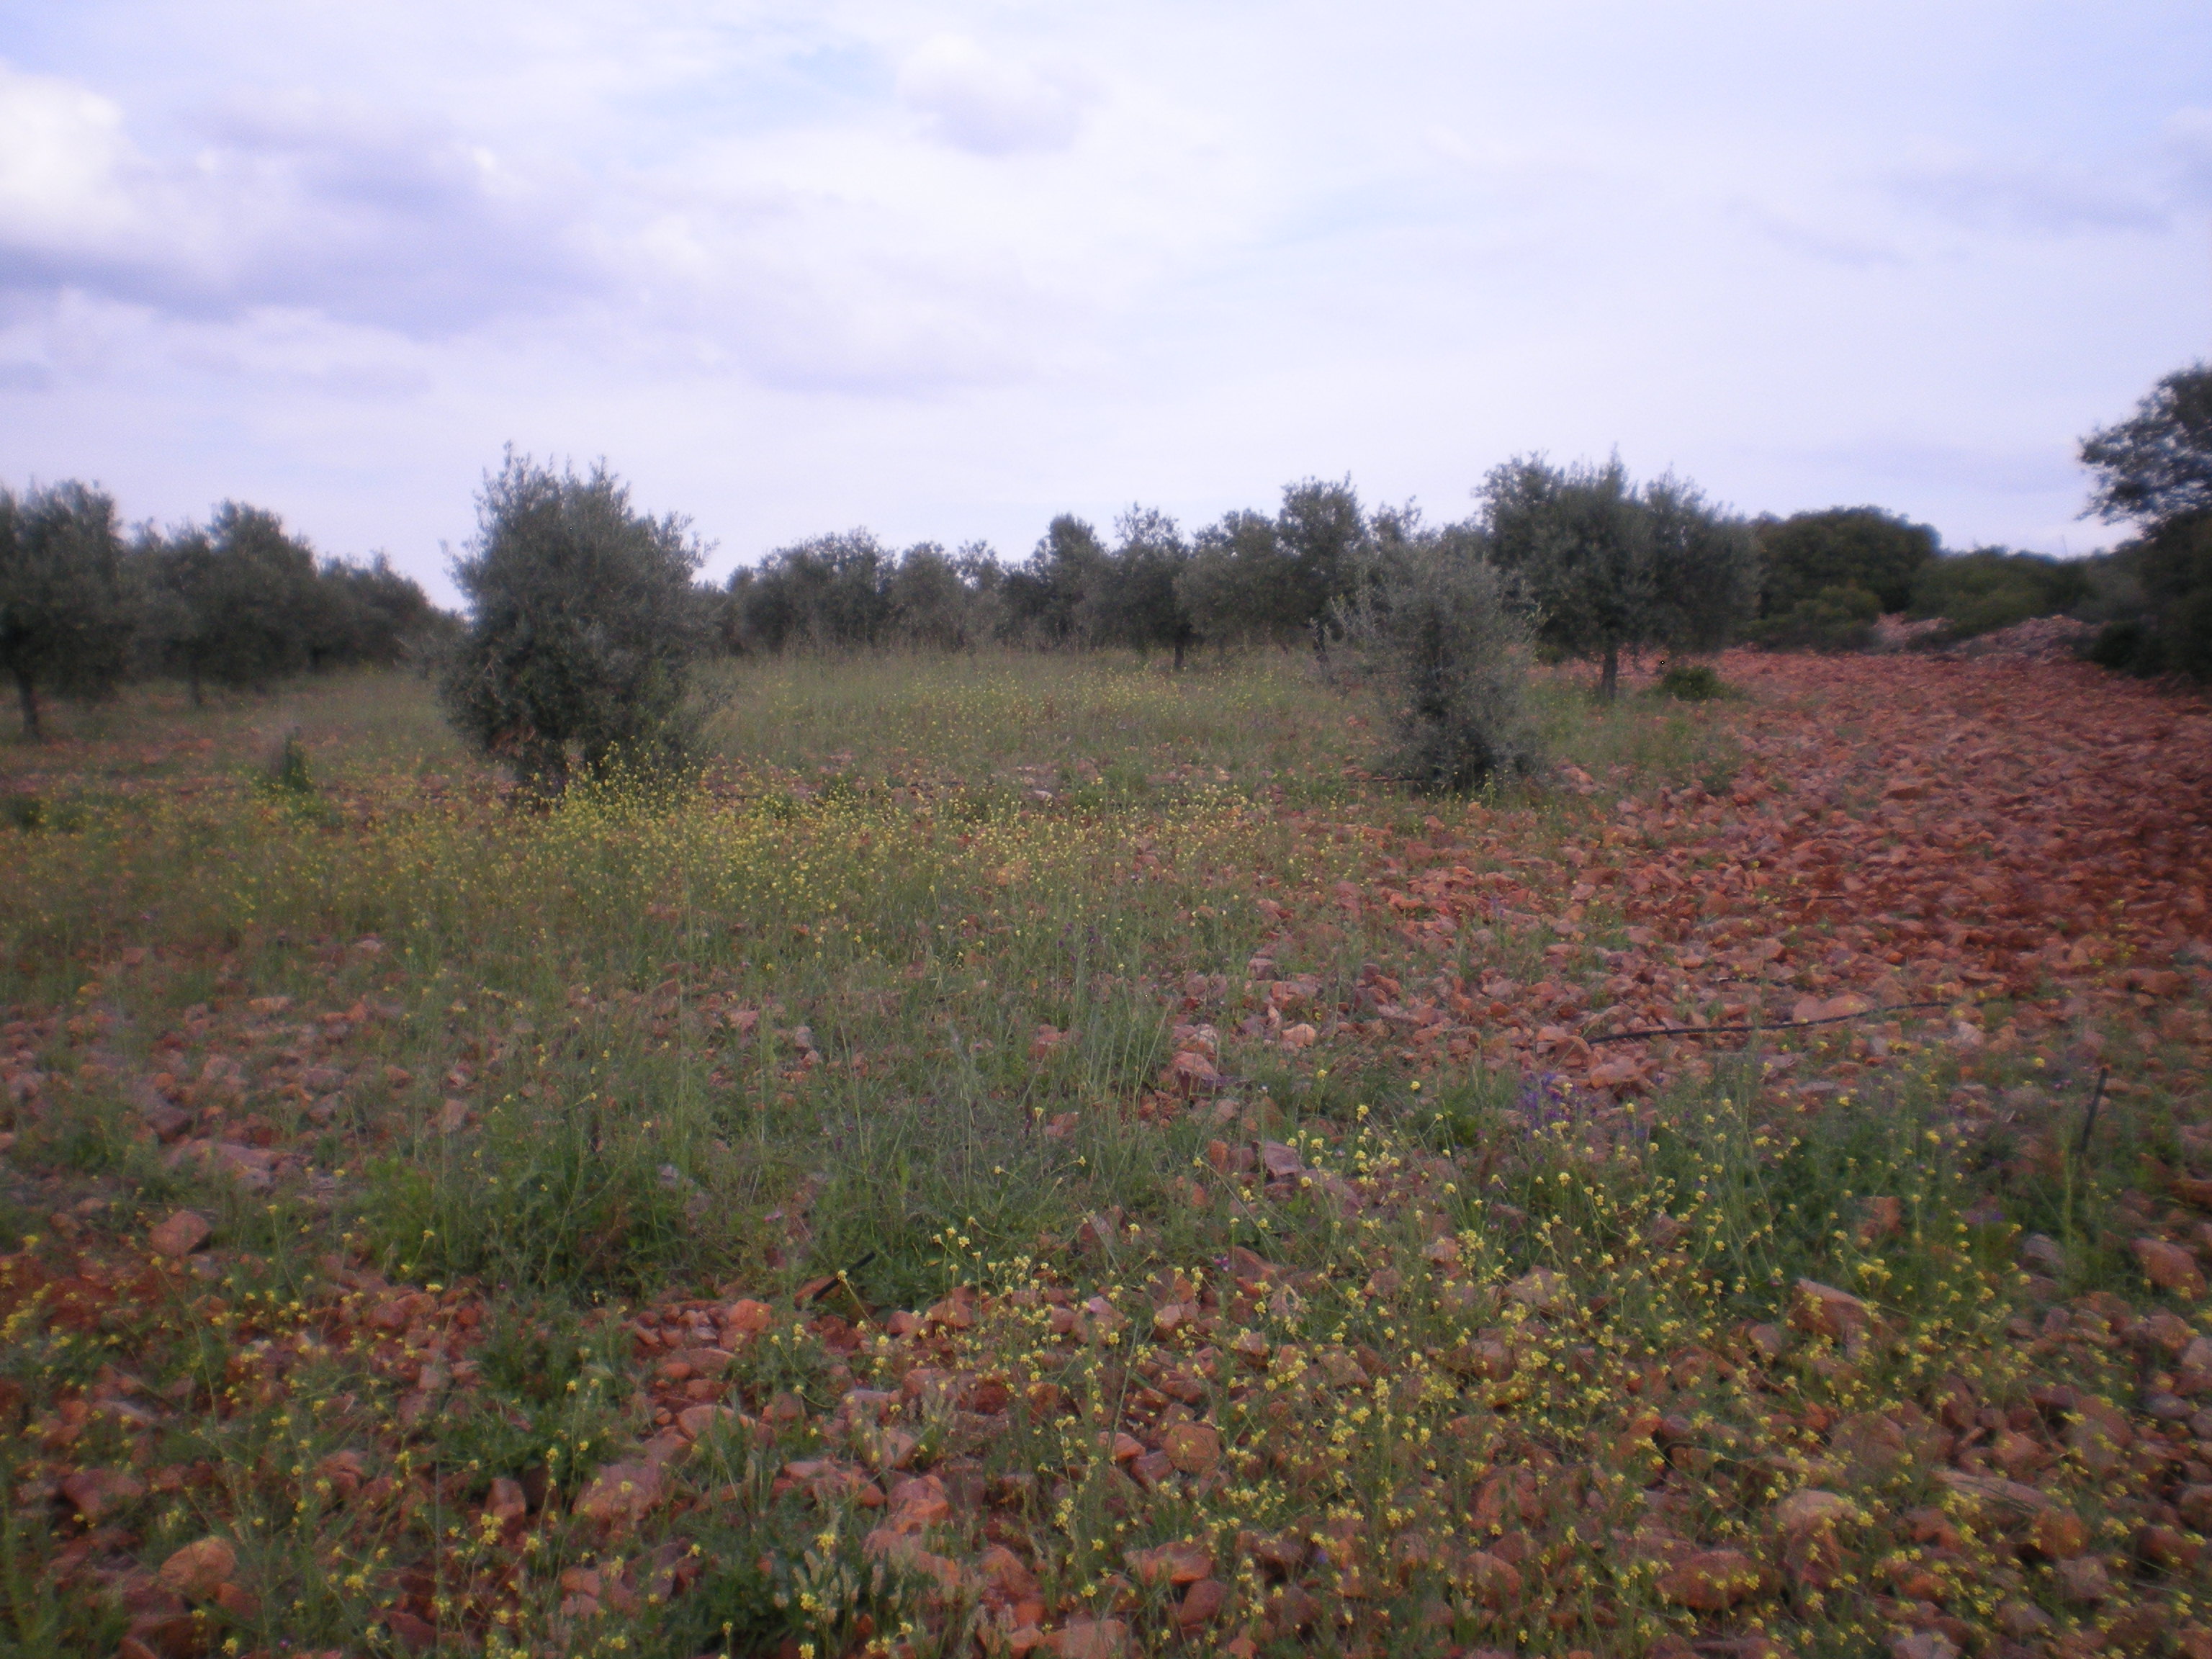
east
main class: Cropland
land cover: Olive groves
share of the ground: 10 - 25 %
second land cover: Spontaneously vegetated surfaces
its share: 25 - 50 %
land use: Agriculture (excluding fallow land and kitchen gardens)
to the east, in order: Olive groves; Spontaneously vegetated surfaces
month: April
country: ES
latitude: 38.8636
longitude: -3.5557
